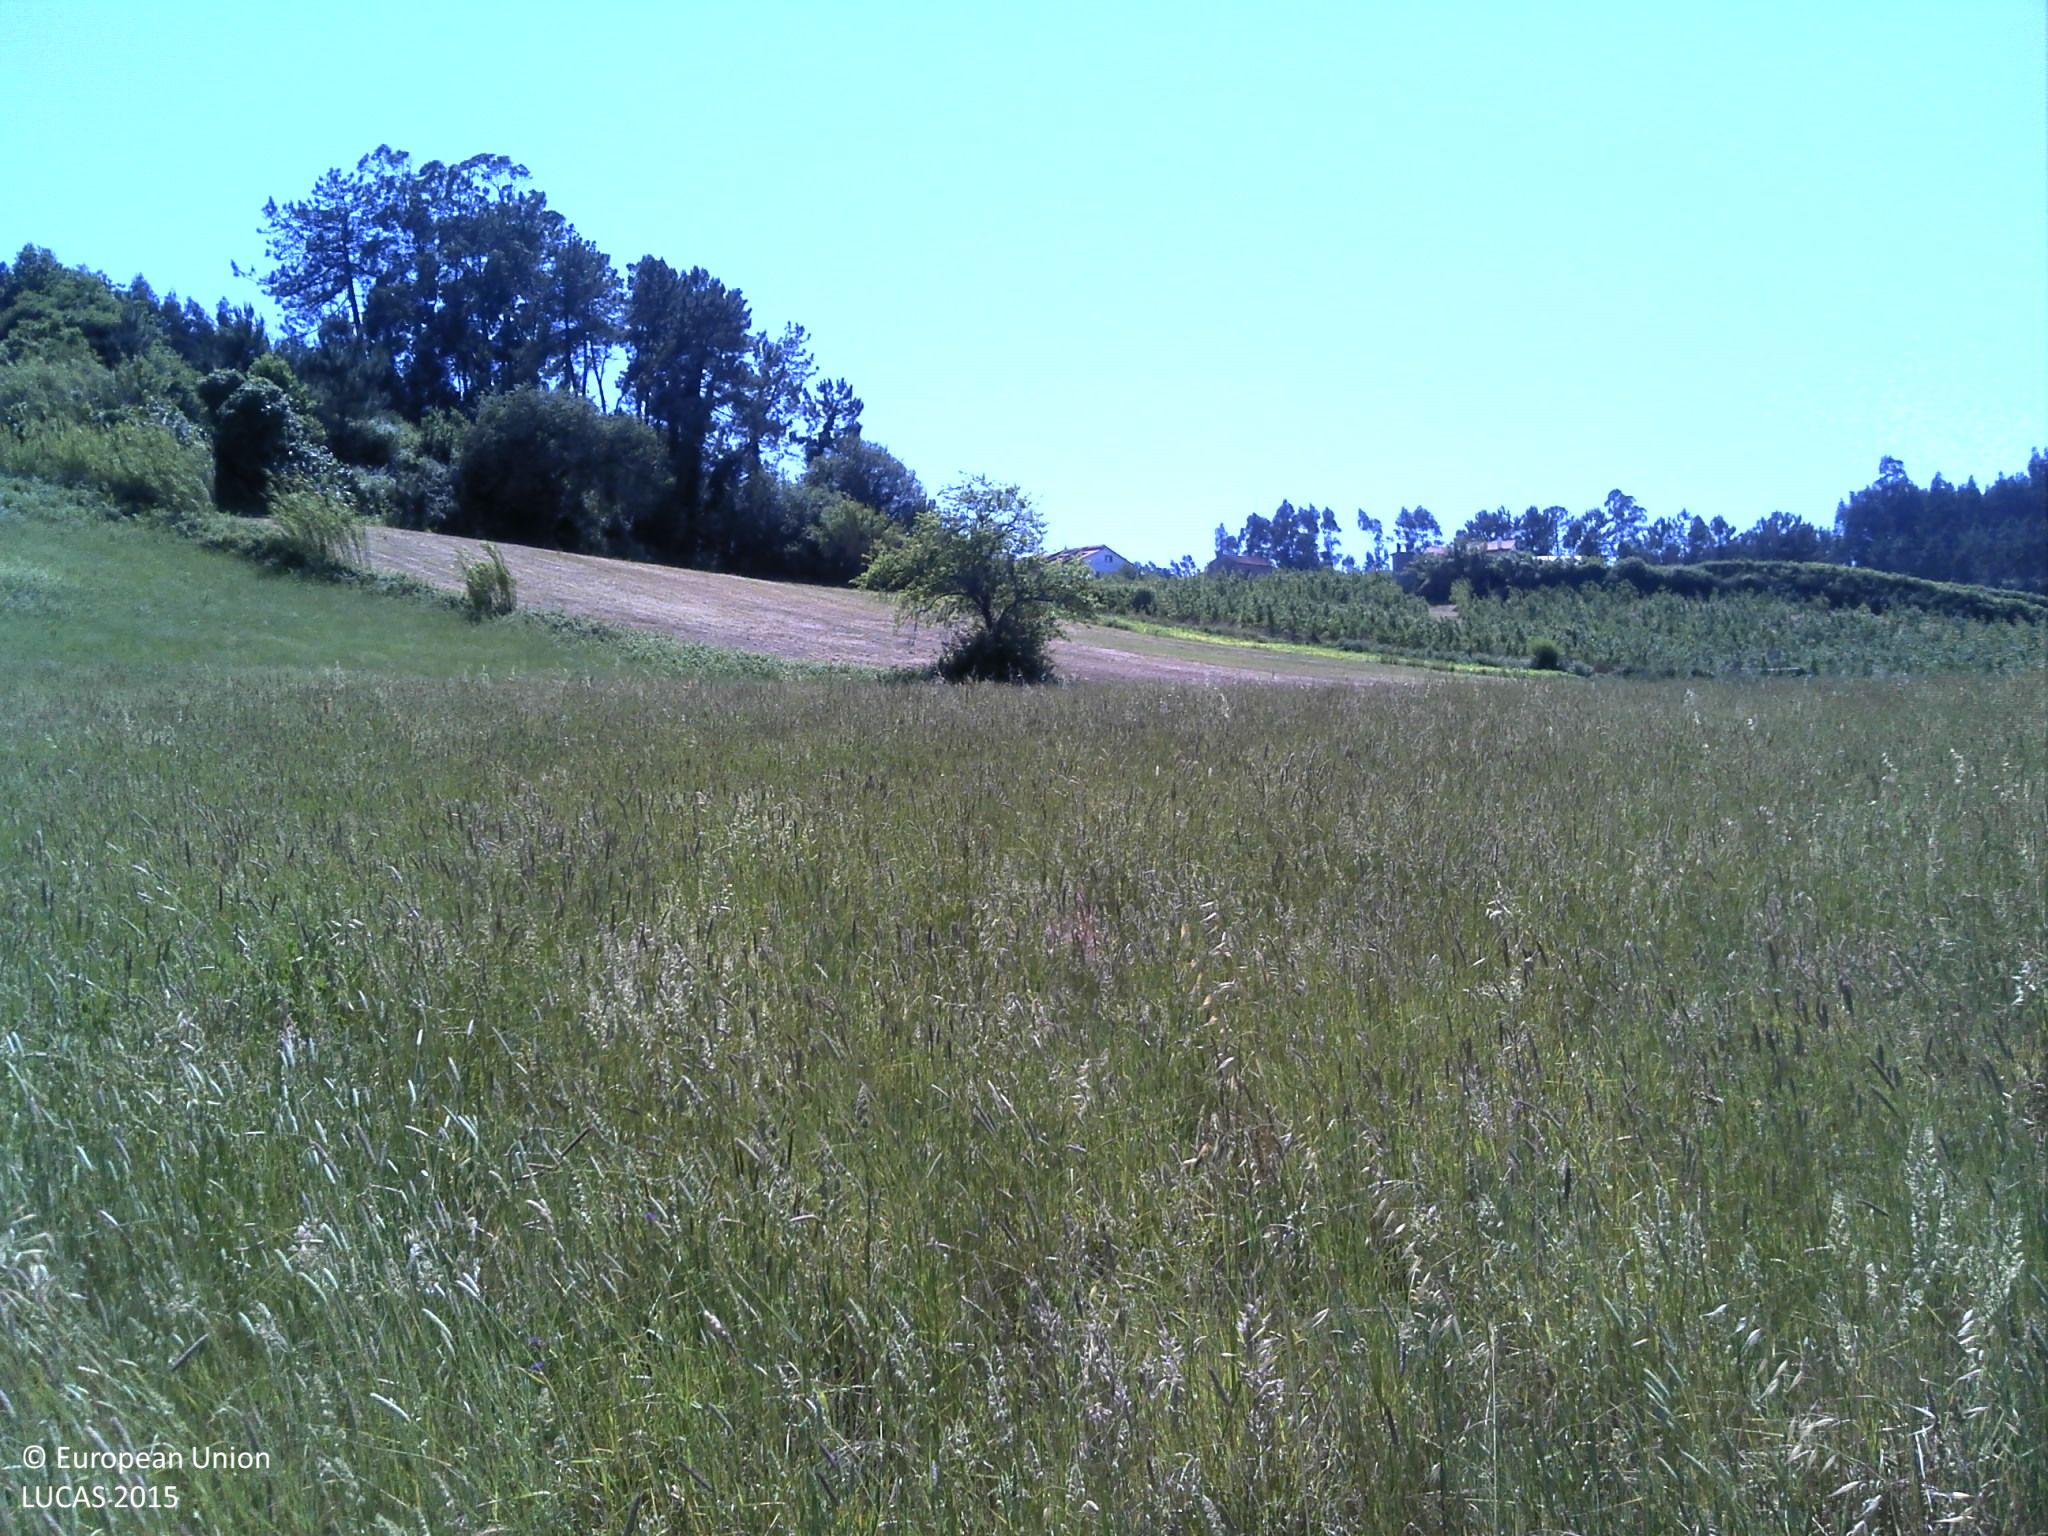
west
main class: Grassland
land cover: Grassland without tree/shrub cover
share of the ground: 50 - 75 %
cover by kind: herbaceous plants 80 %, unconsolidated bare surface 15 %, shrubs 5 %
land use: Agriculture (excluding fallow land and kitchen gardens)
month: June
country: PT
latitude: 39.6769
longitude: -8.8683
